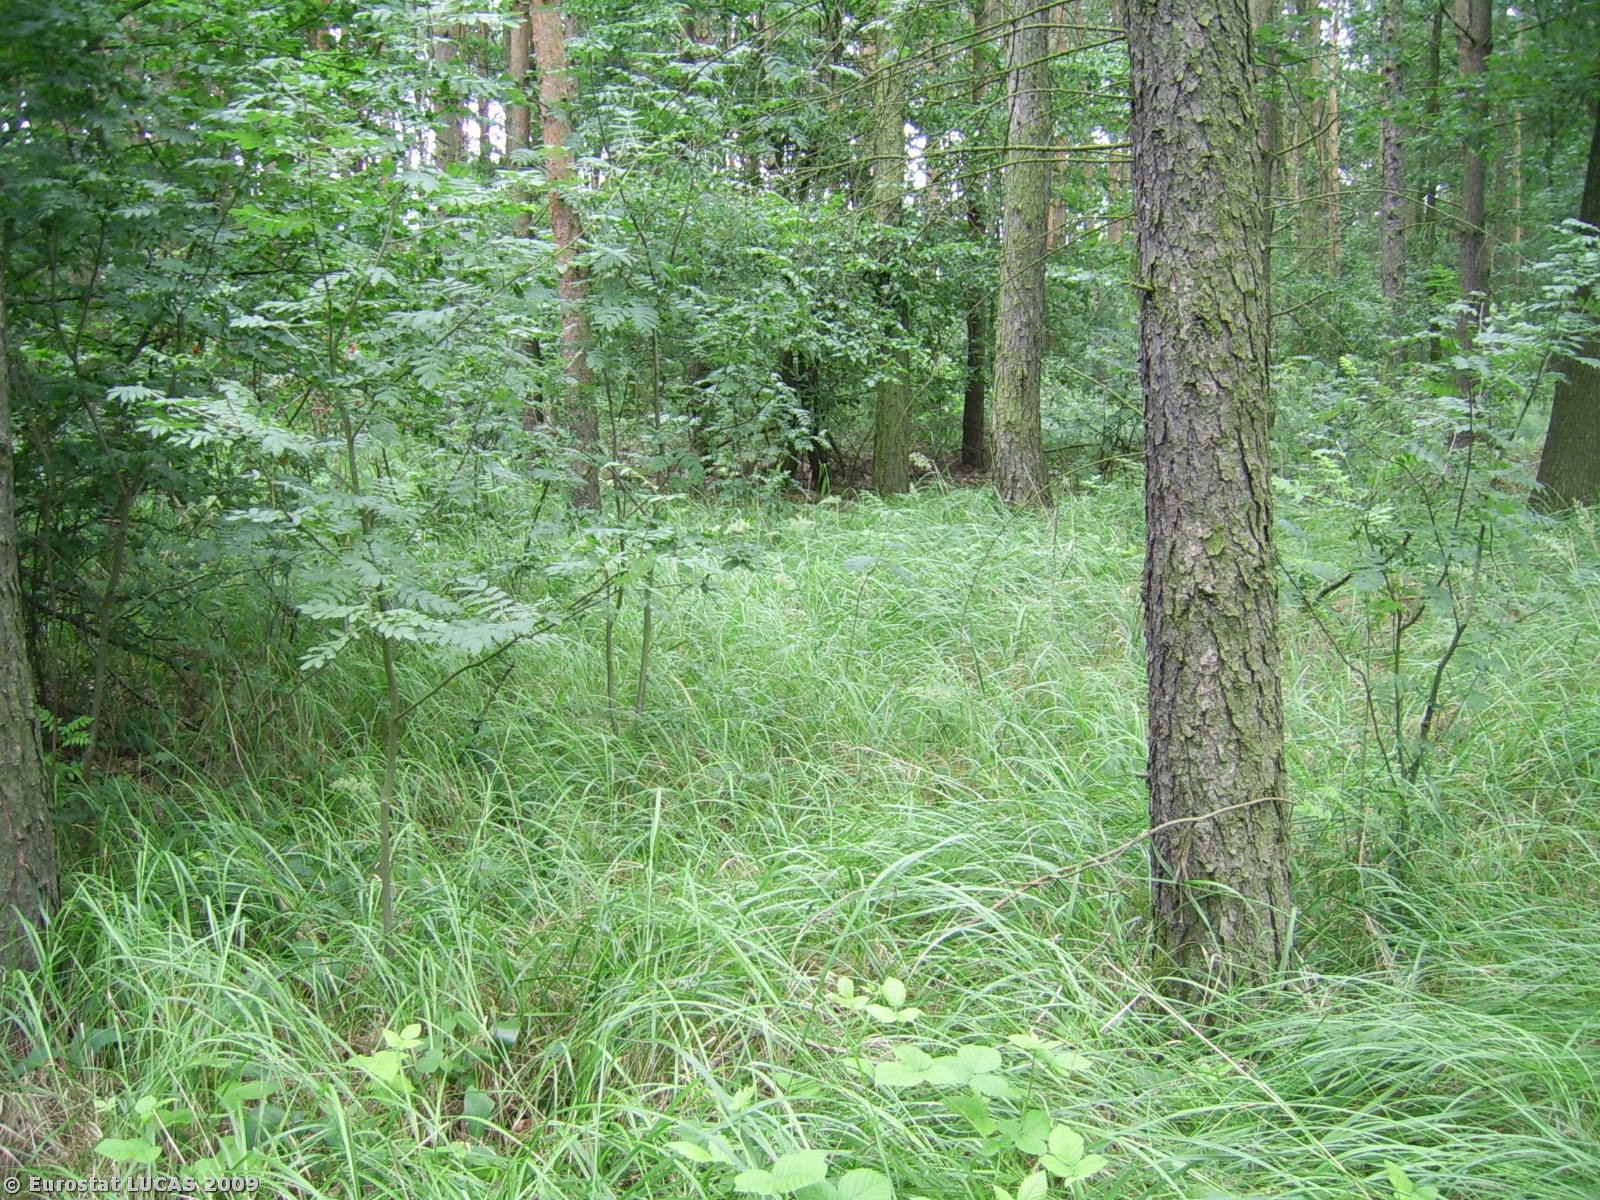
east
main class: Woodland
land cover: Mixed woodland
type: hemiboreal forest and nemoral coniferous forest and mixed broadleaved-coniferous forest
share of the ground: 50 - 75 %
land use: Unused
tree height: > 5 m
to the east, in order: Mixed woodland; Tracks; Mixed woodland
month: July
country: PL
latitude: 53.1757
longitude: 18.2305
